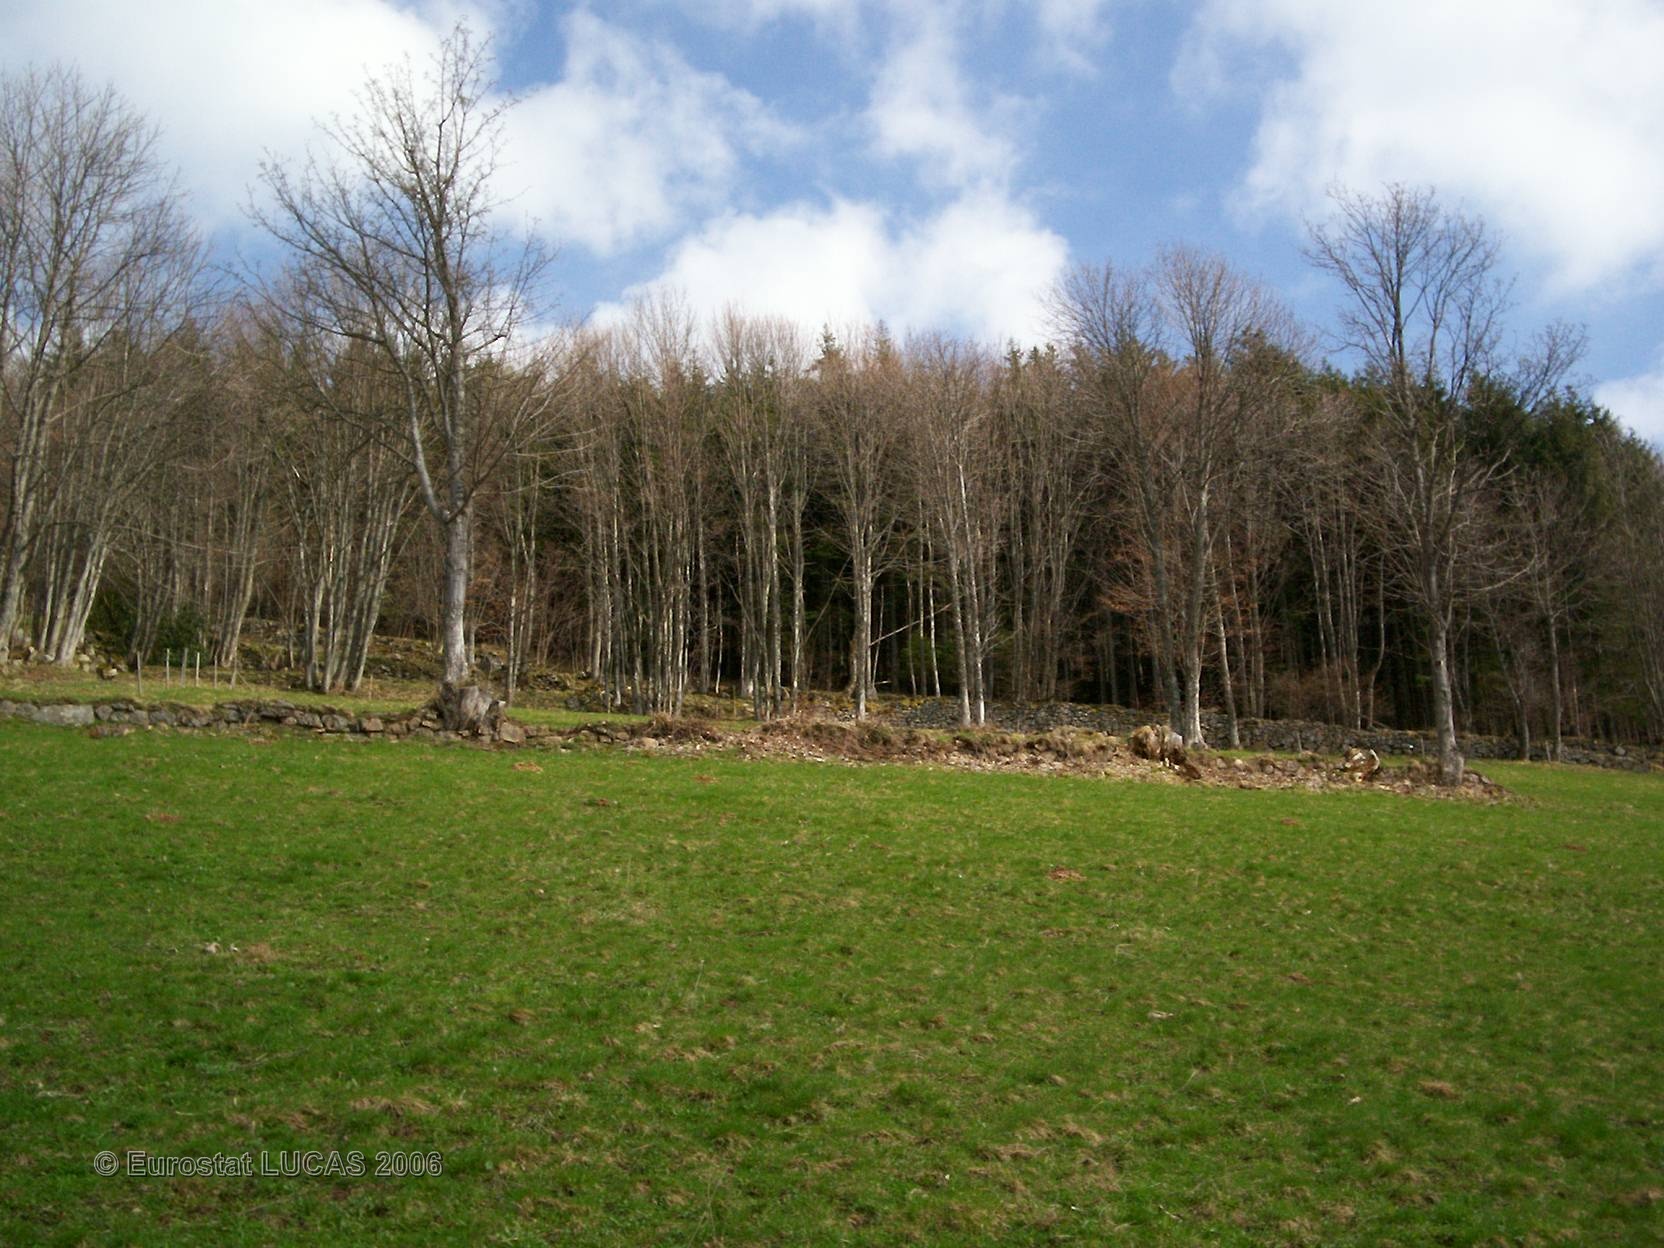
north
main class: Grassland
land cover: Grassland without tree/shrub cover
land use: Agriculture (excluding fallow land and kitchen gardens)
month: April
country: FR
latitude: 48.1317
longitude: 7.1122
